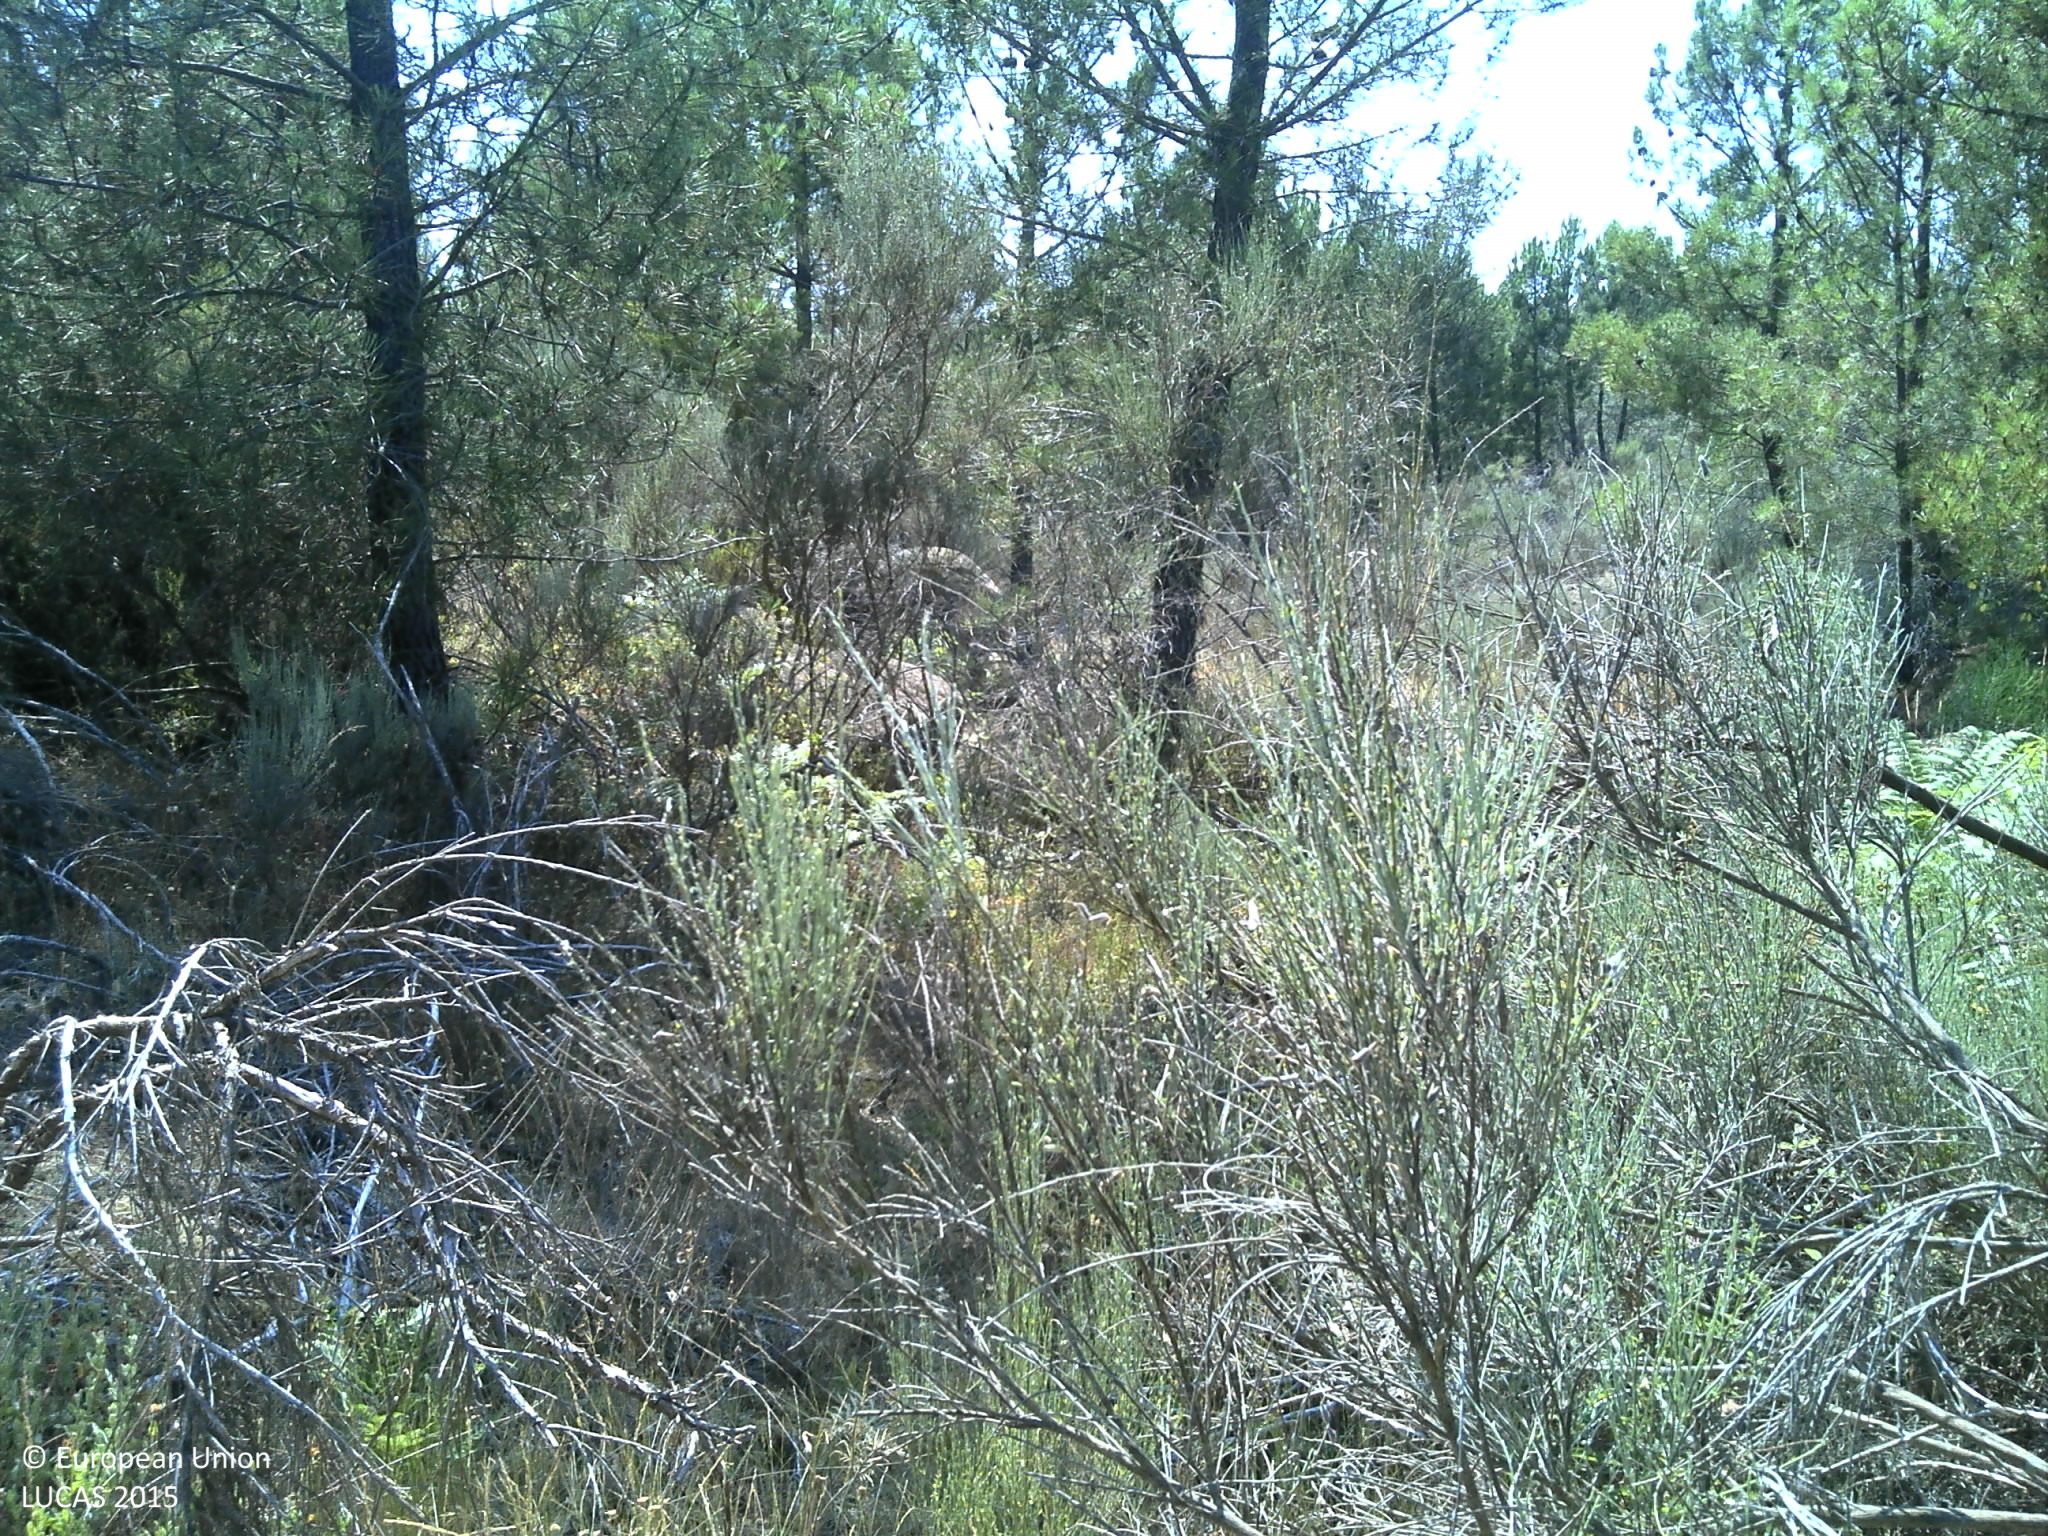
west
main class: Shrubland
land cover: Shrubland with sparse tree cover
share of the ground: 50 - 75 %
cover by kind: shrubs 50 %, herbaceous plants 20 %, consolidated bare surface 20 %, broadleaved forest trees 5 %, unconsolidated bare surface 5 %
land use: Semi-natural and natural areas not in use
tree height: > 5 m
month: July
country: PT
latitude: 40.8246
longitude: -7.5841
